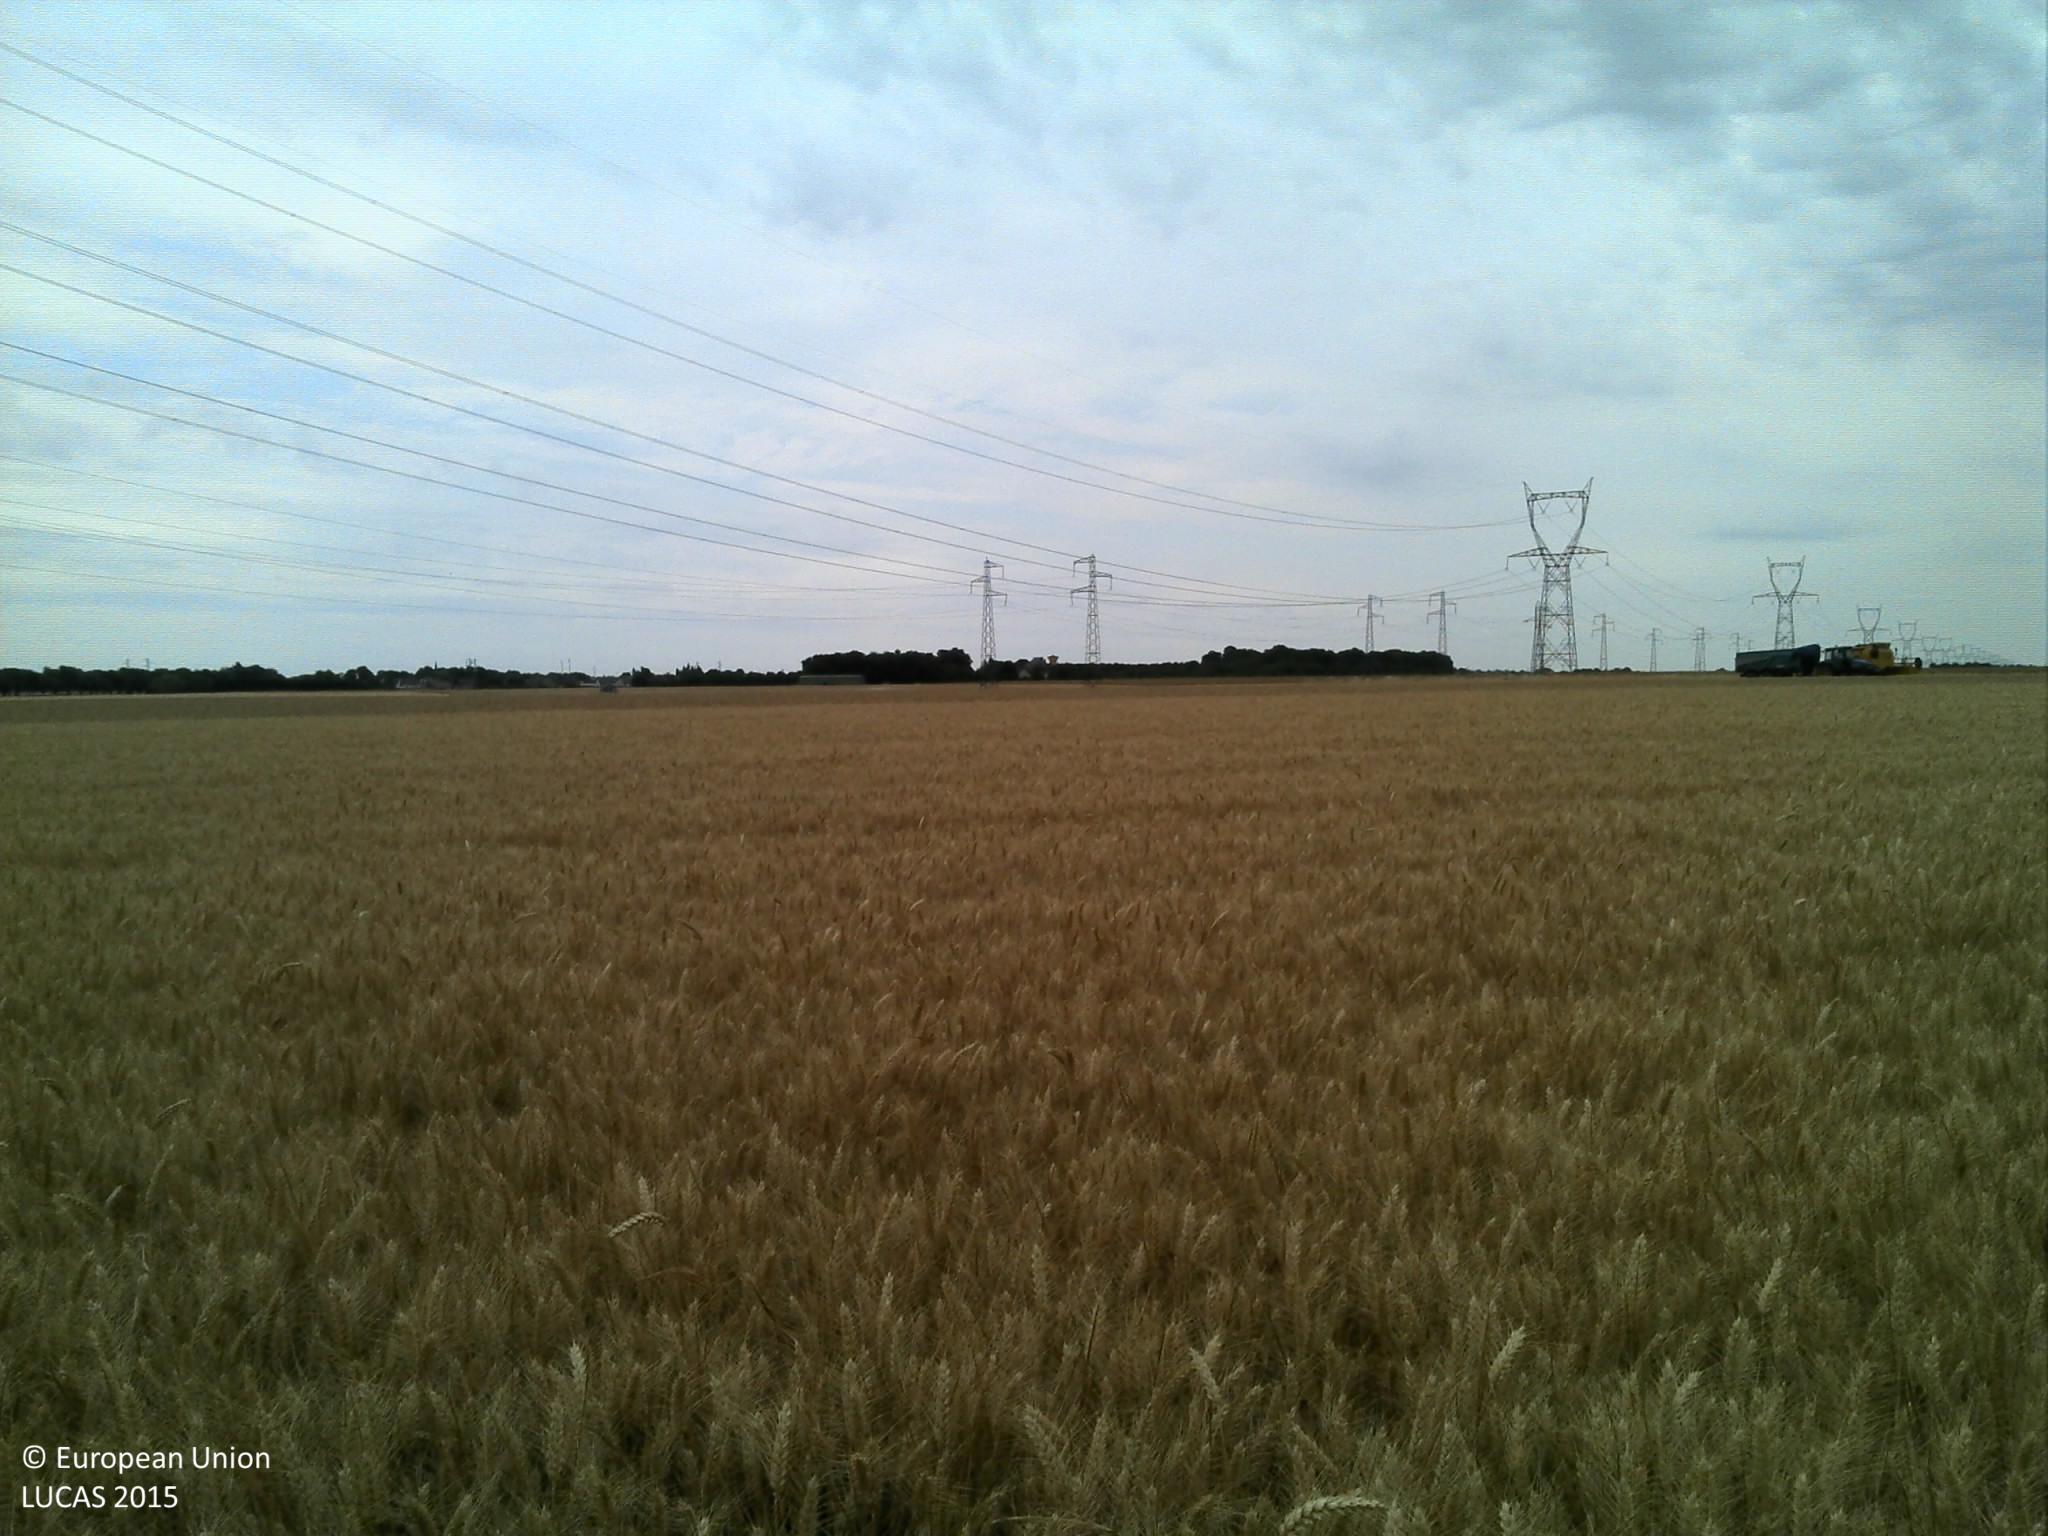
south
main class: Cropland
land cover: Durum wheat
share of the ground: > 75 %
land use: Agriculture (excluding fallow land and kitchen gardens)
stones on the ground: < 10 %
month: July
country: FR
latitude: 48.3294
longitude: 1.9881
